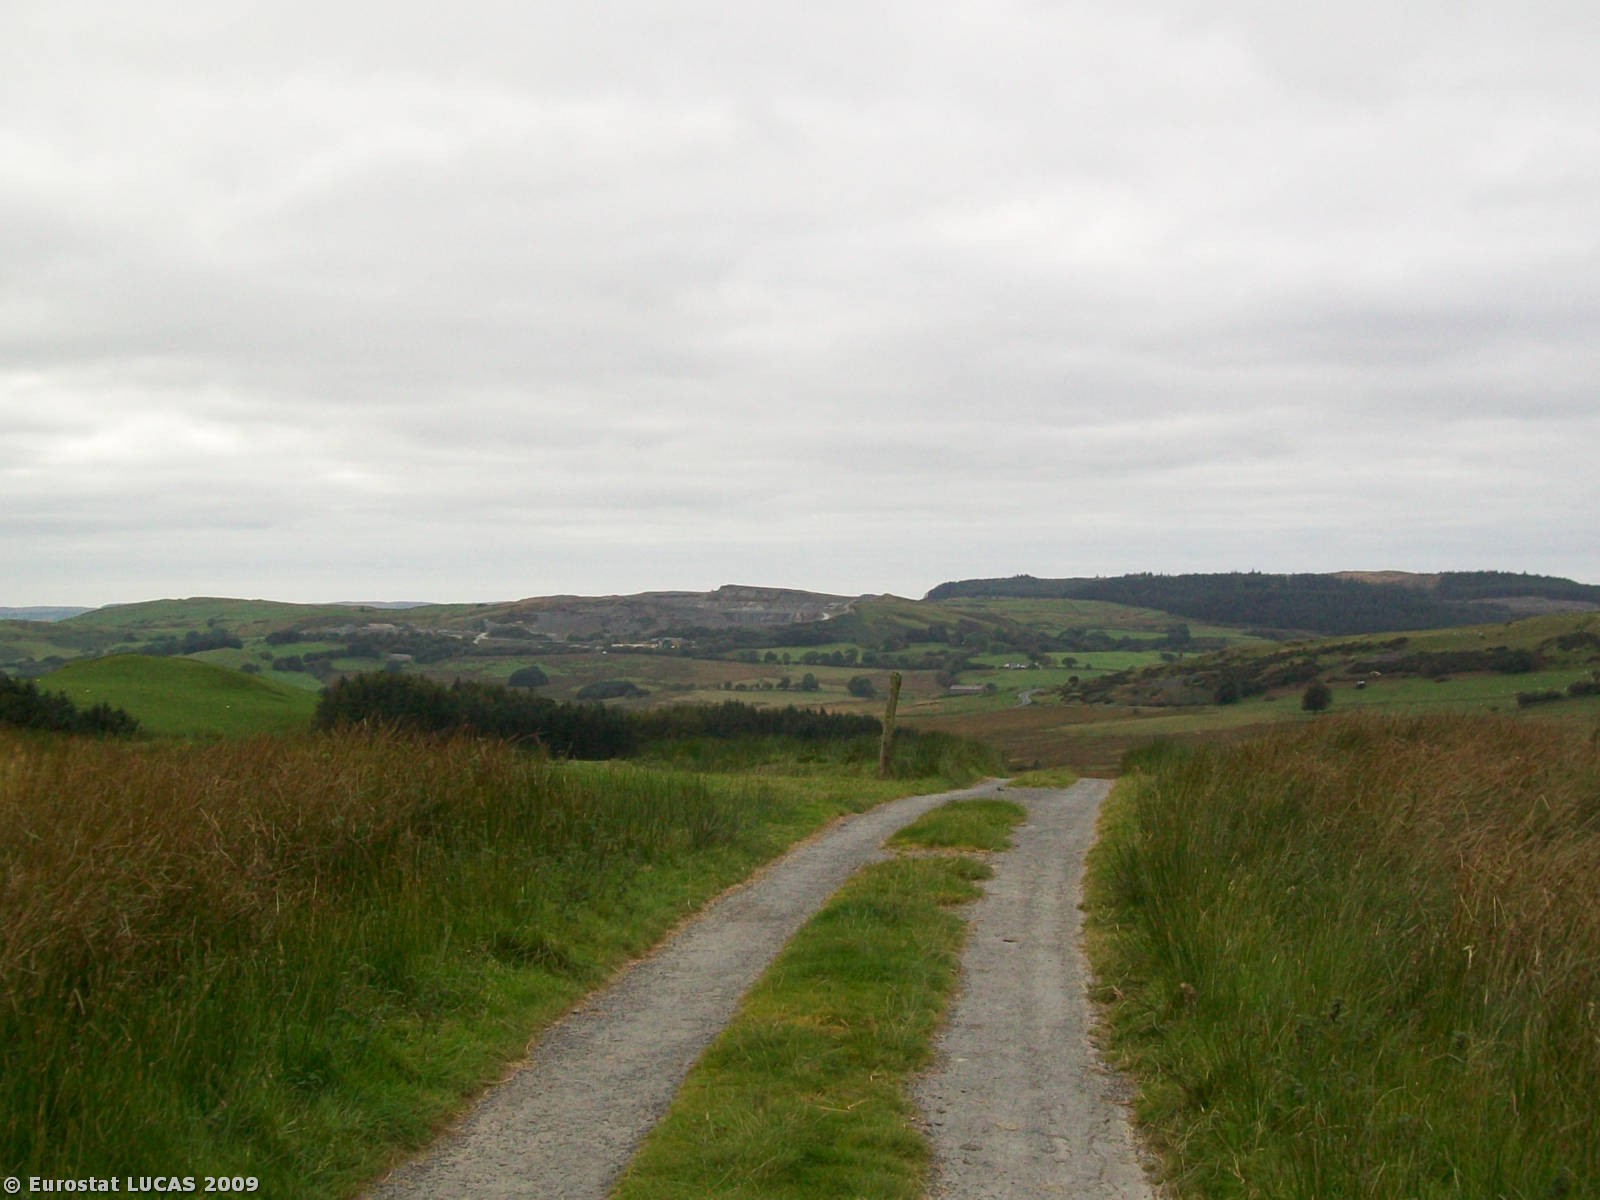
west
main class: Grassland
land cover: Grassland without tree/shrub cover
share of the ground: > 75 %
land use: Agriculture (excluding fallow land and kitchen gardens)
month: September
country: GB
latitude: 52.3105
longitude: -3.8348
